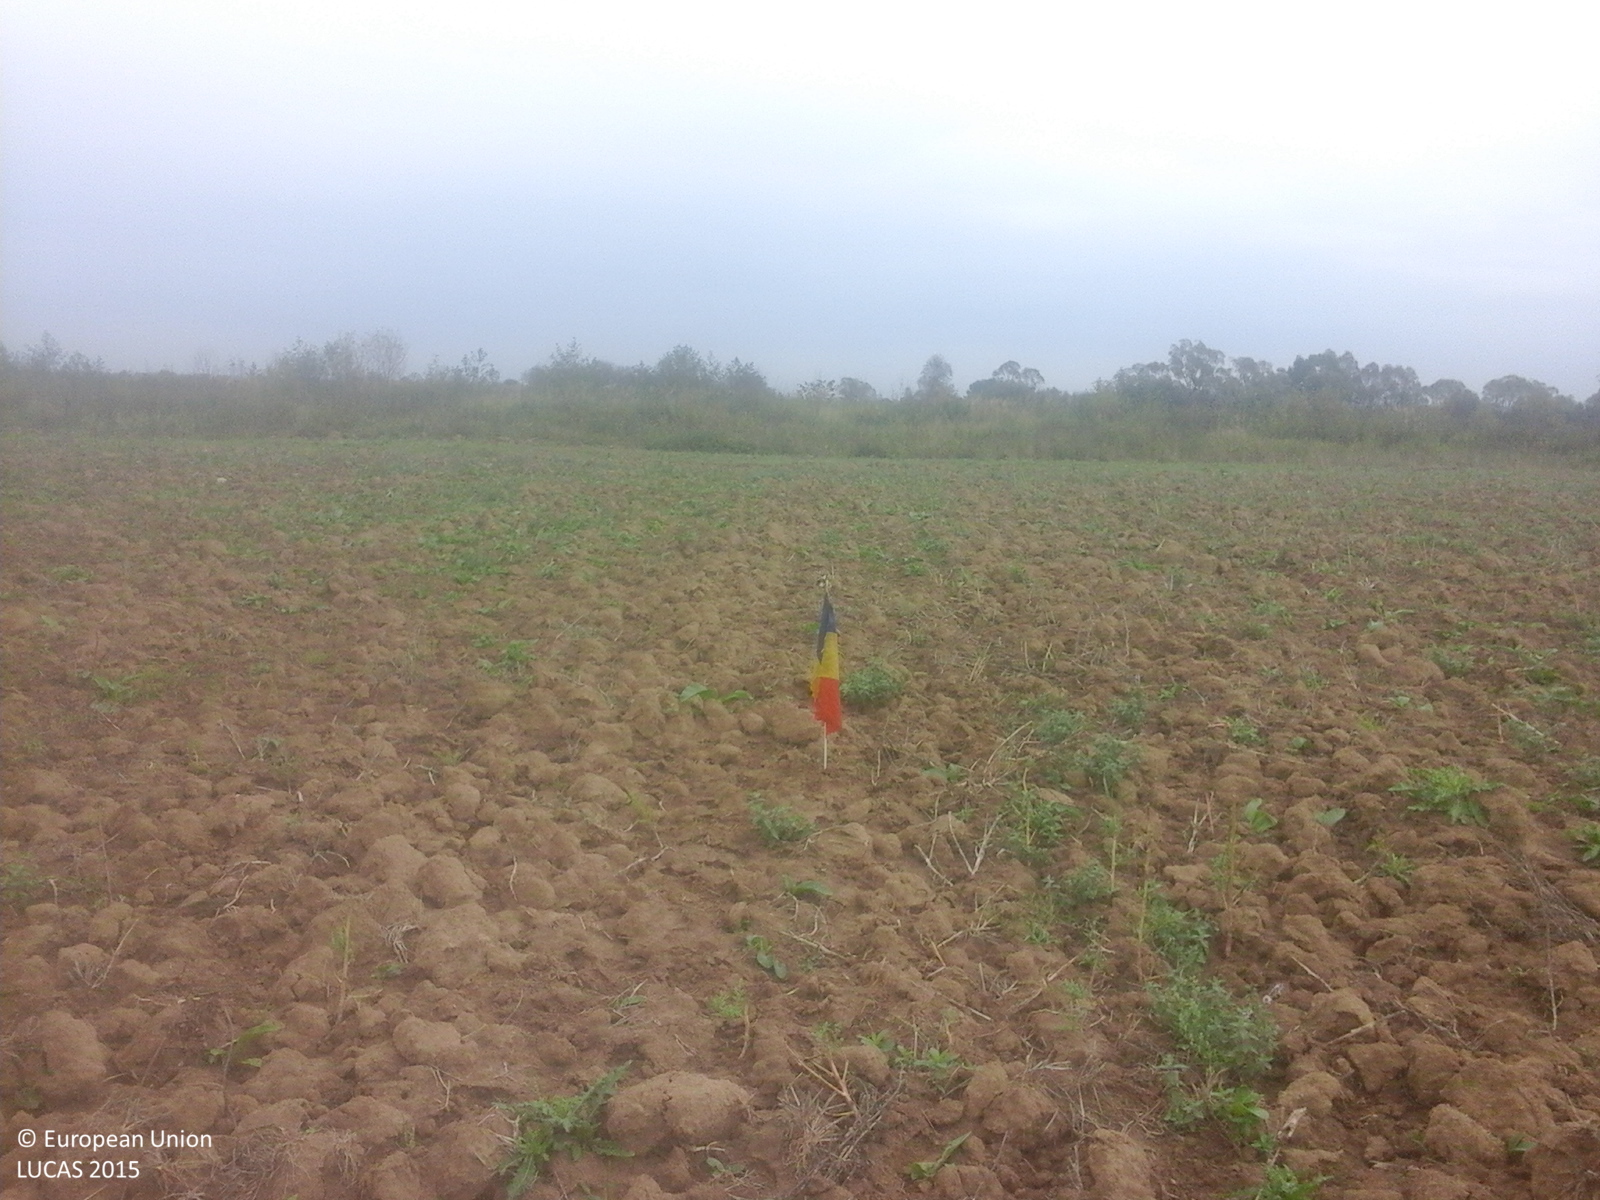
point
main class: Cropland
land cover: Maize
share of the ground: < 10 %
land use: Agriculture (excluding fallow land and kitchen gardens)
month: September
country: RO
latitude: 45.8456
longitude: 22.0814
